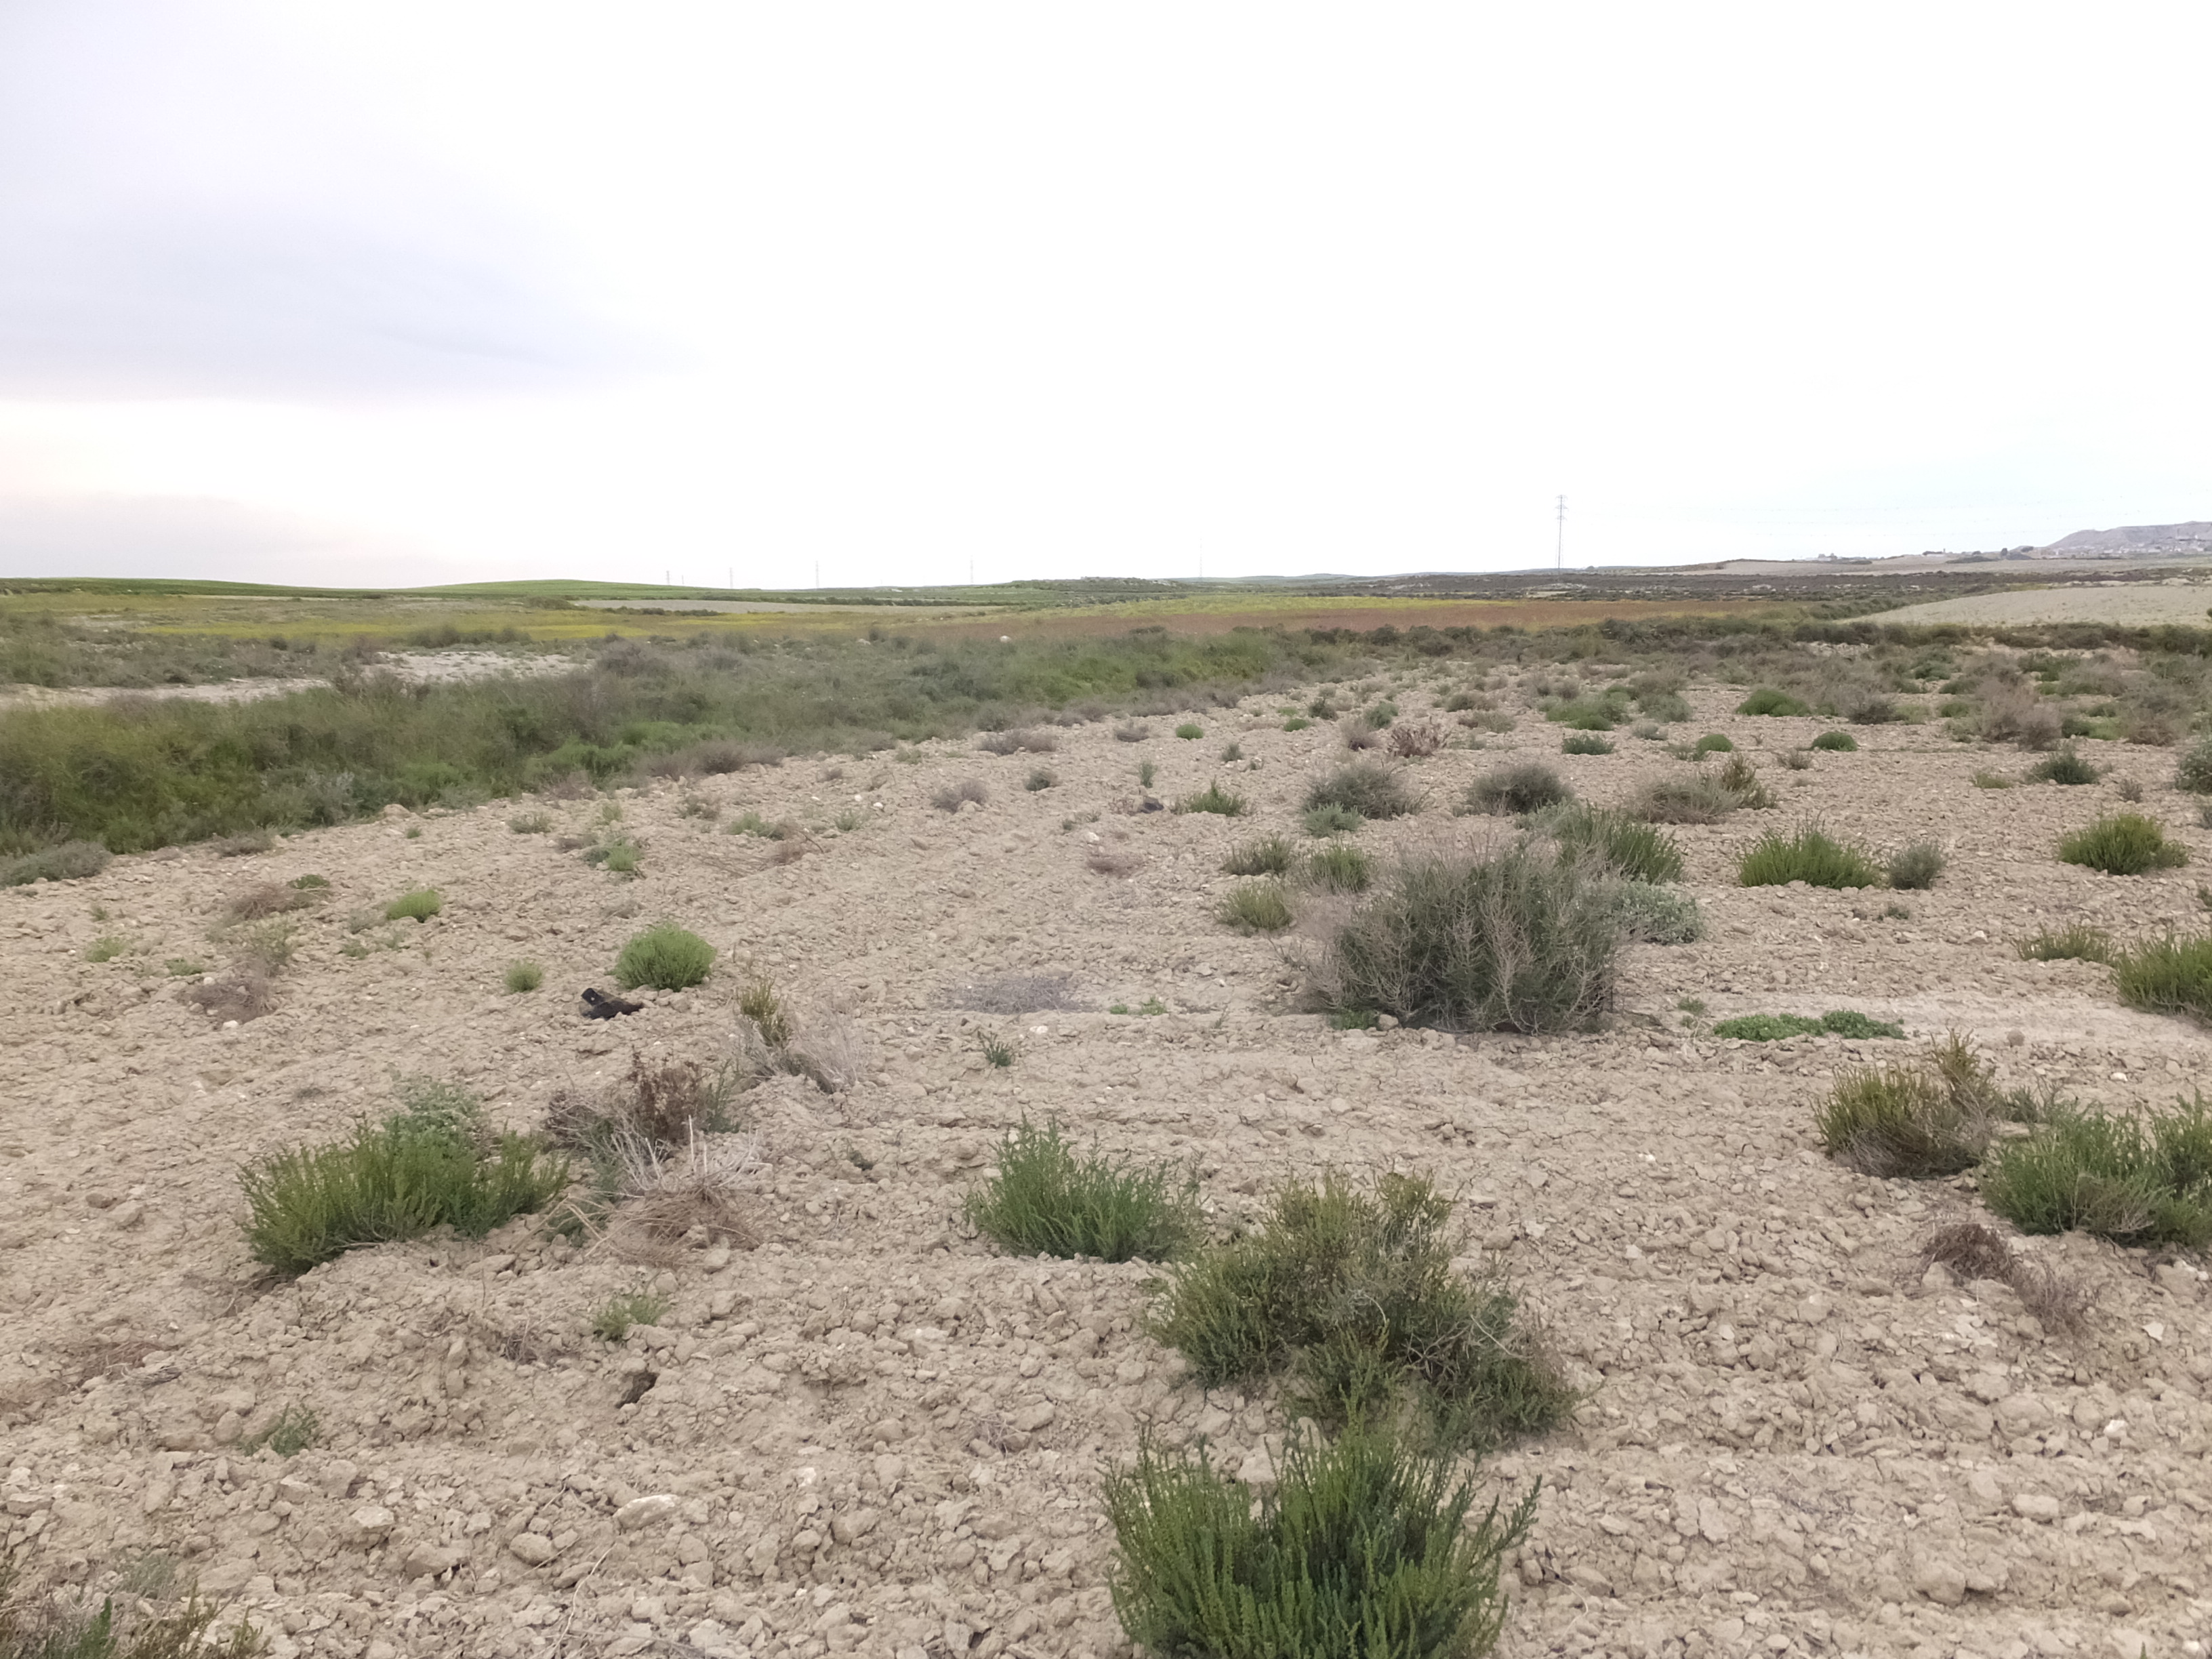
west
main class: Shrubland
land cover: Shrubland with sparse tree cover
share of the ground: 25 - 50 %
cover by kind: unconsolidated bare surface 55 %, shrubs 40 %, coniferous forest trees 5 %
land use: Forestry
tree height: < 5 m
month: April
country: ES
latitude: 41.5406
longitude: -0.1689
